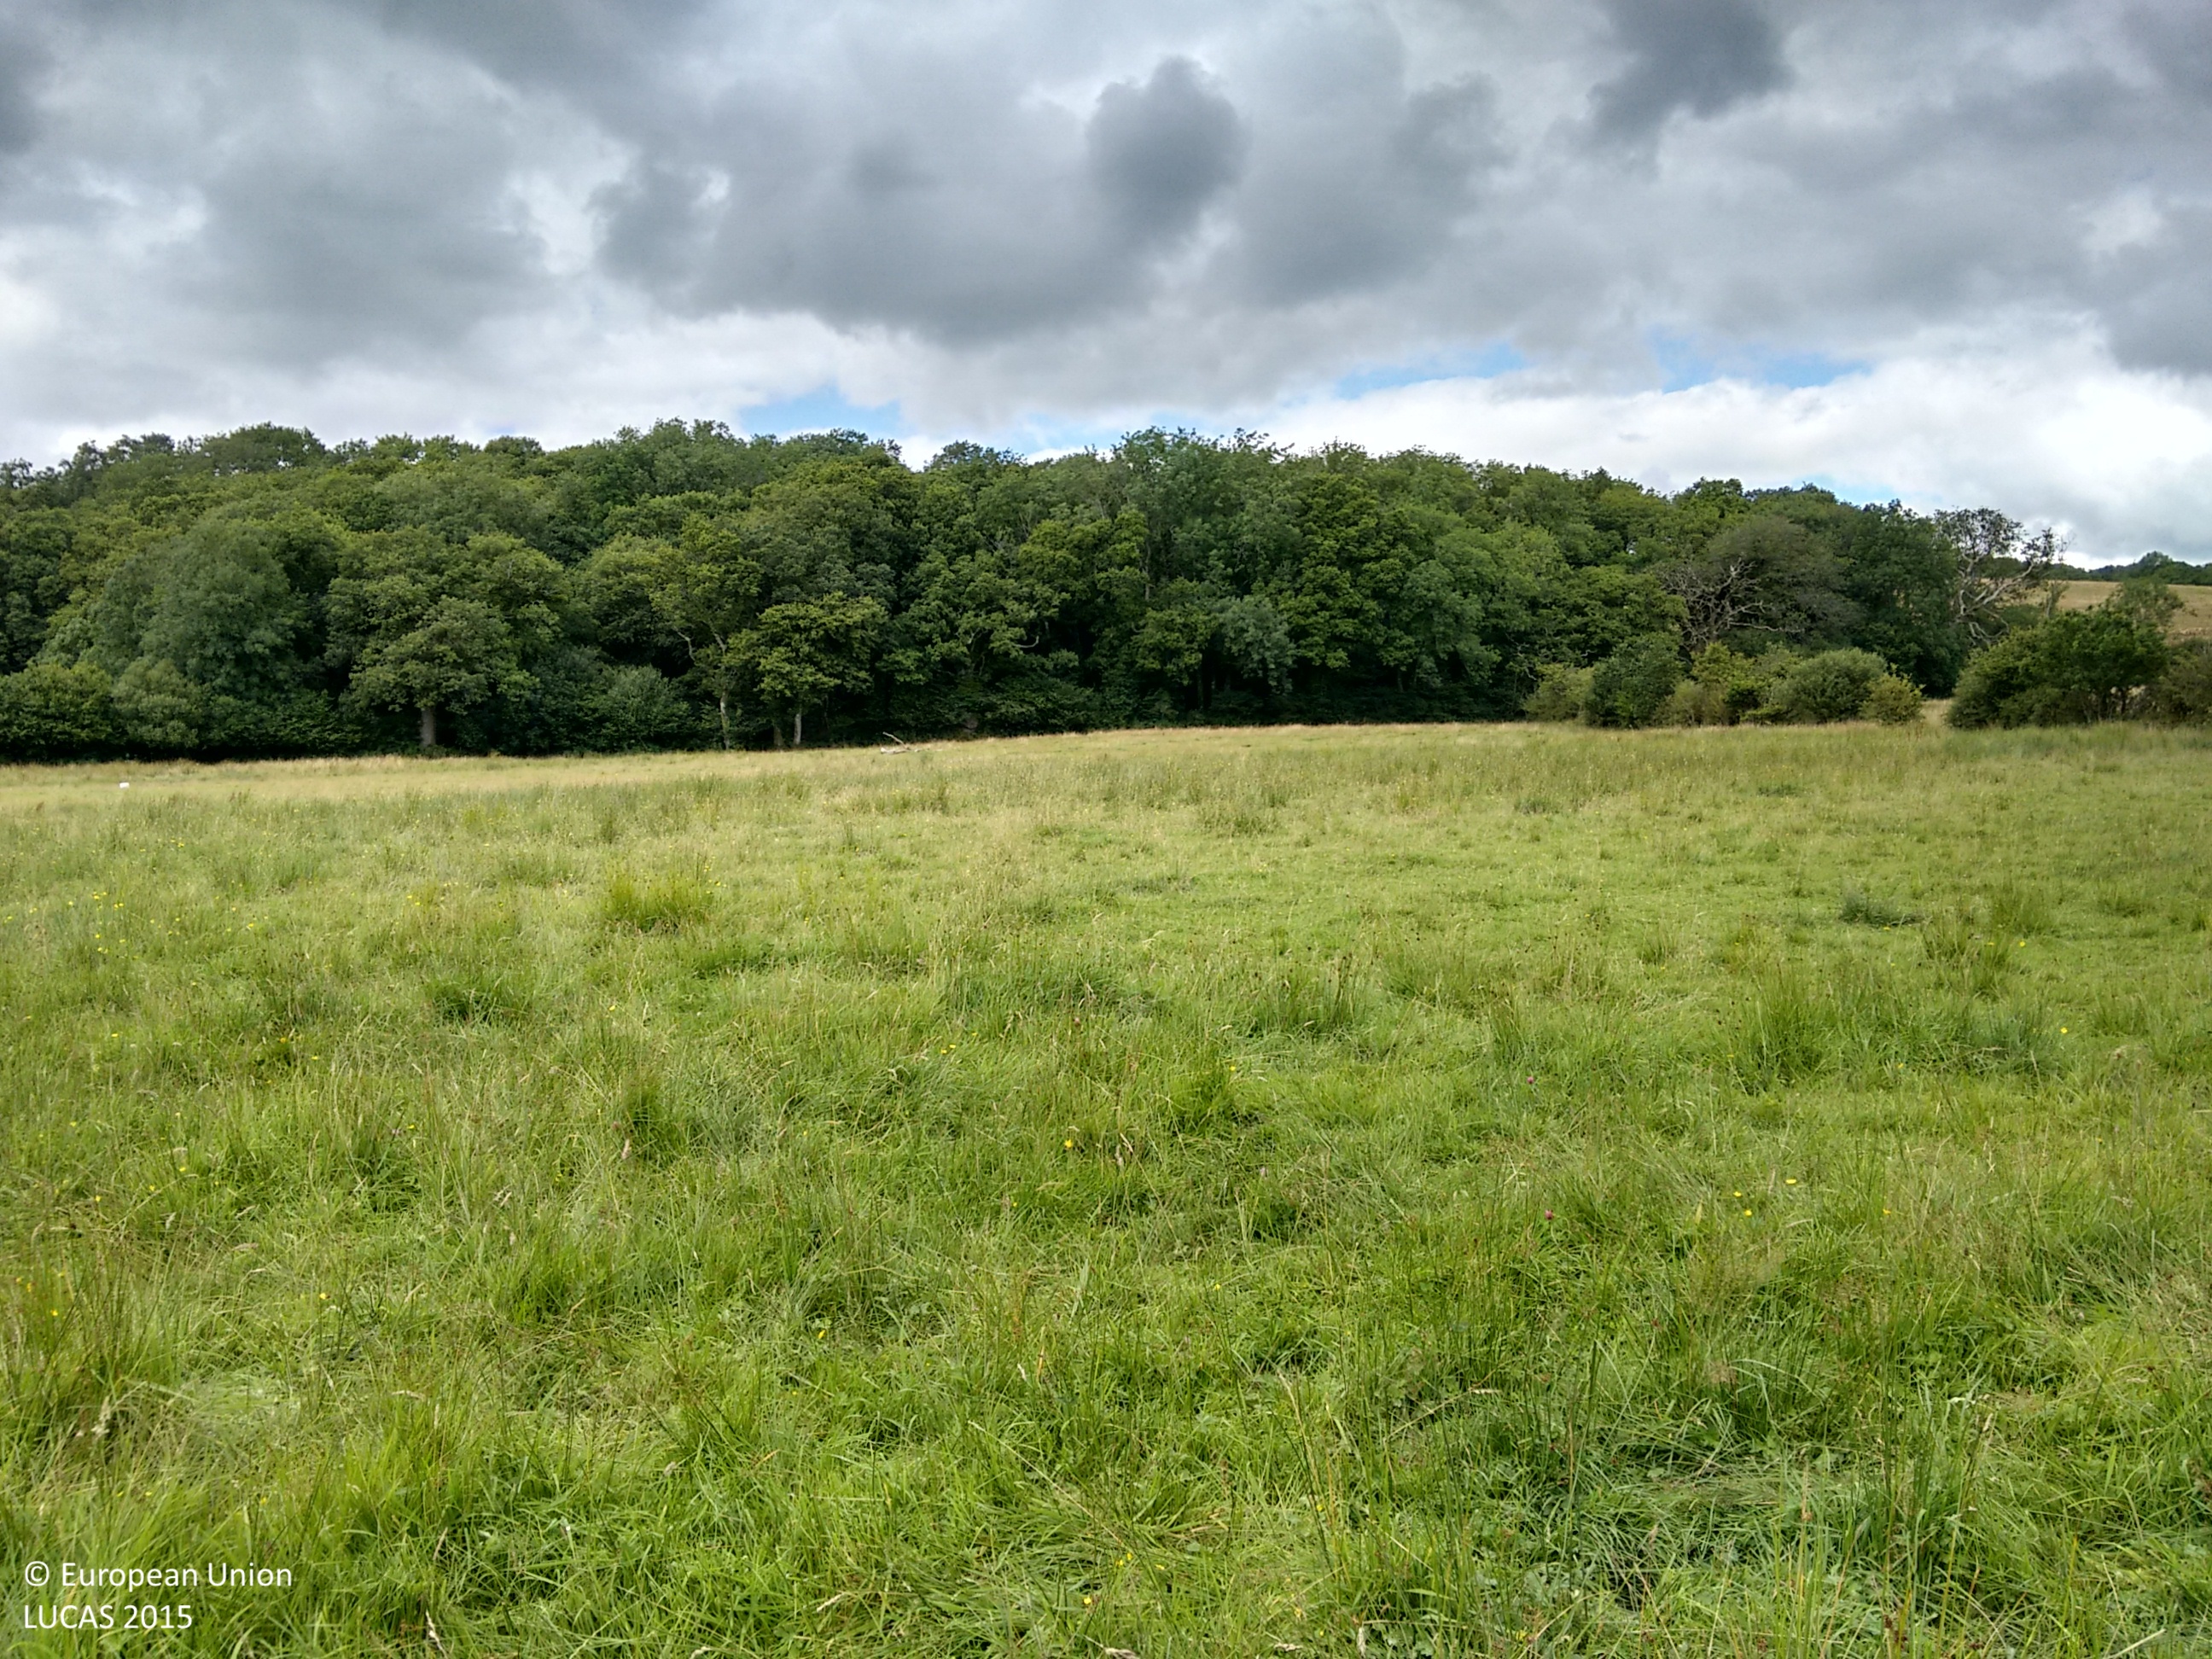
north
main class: Grassland
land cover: Grassland without tree/shrub cover
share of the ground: > 75 %
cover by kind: herbaceous plants 100 %
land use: Agriculture (excluding fallow land and kitchen gardens)
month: August
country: GB
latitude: 51.8789
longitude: -4.0855
